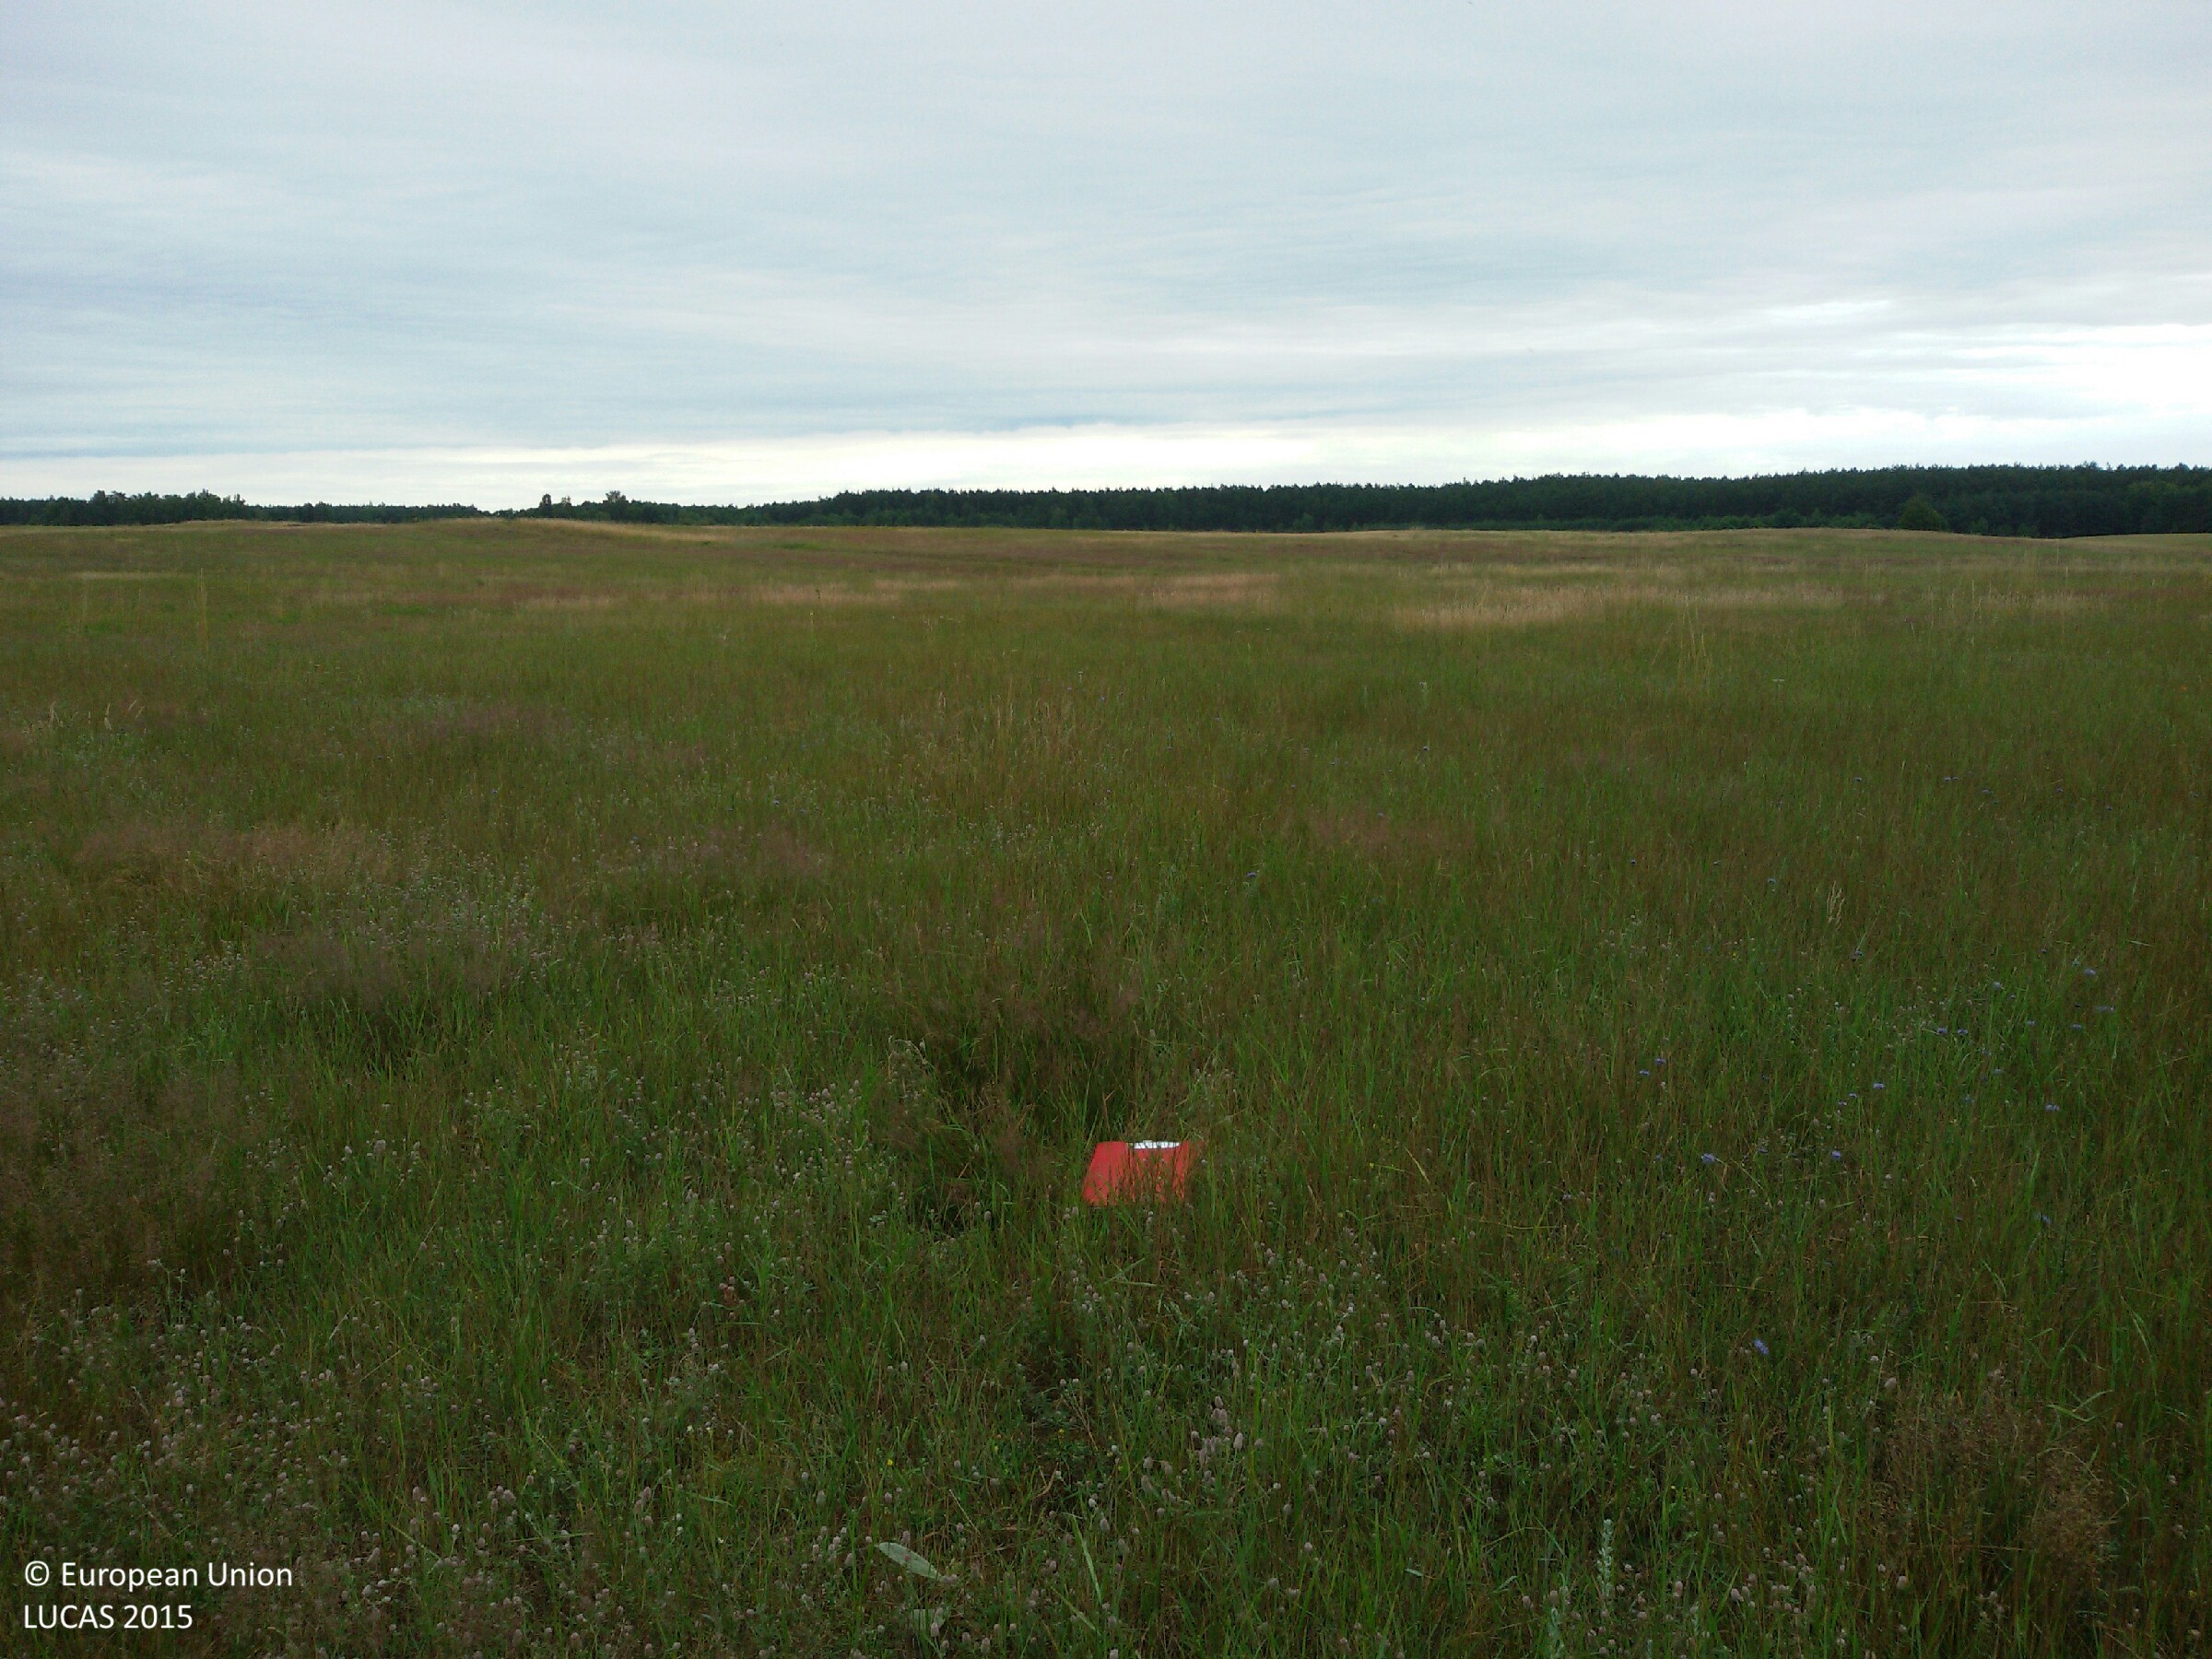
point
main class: Grassland
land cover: Grassland without tree/shrub cover
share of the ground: > 75 %
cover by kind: herbaceous plants 100 %
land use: Agriculture (excluding fallow land and kitchen gardens)
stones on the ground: 10 - 25 %
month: July
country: PL
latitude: 53.3103
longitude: 16.2947
